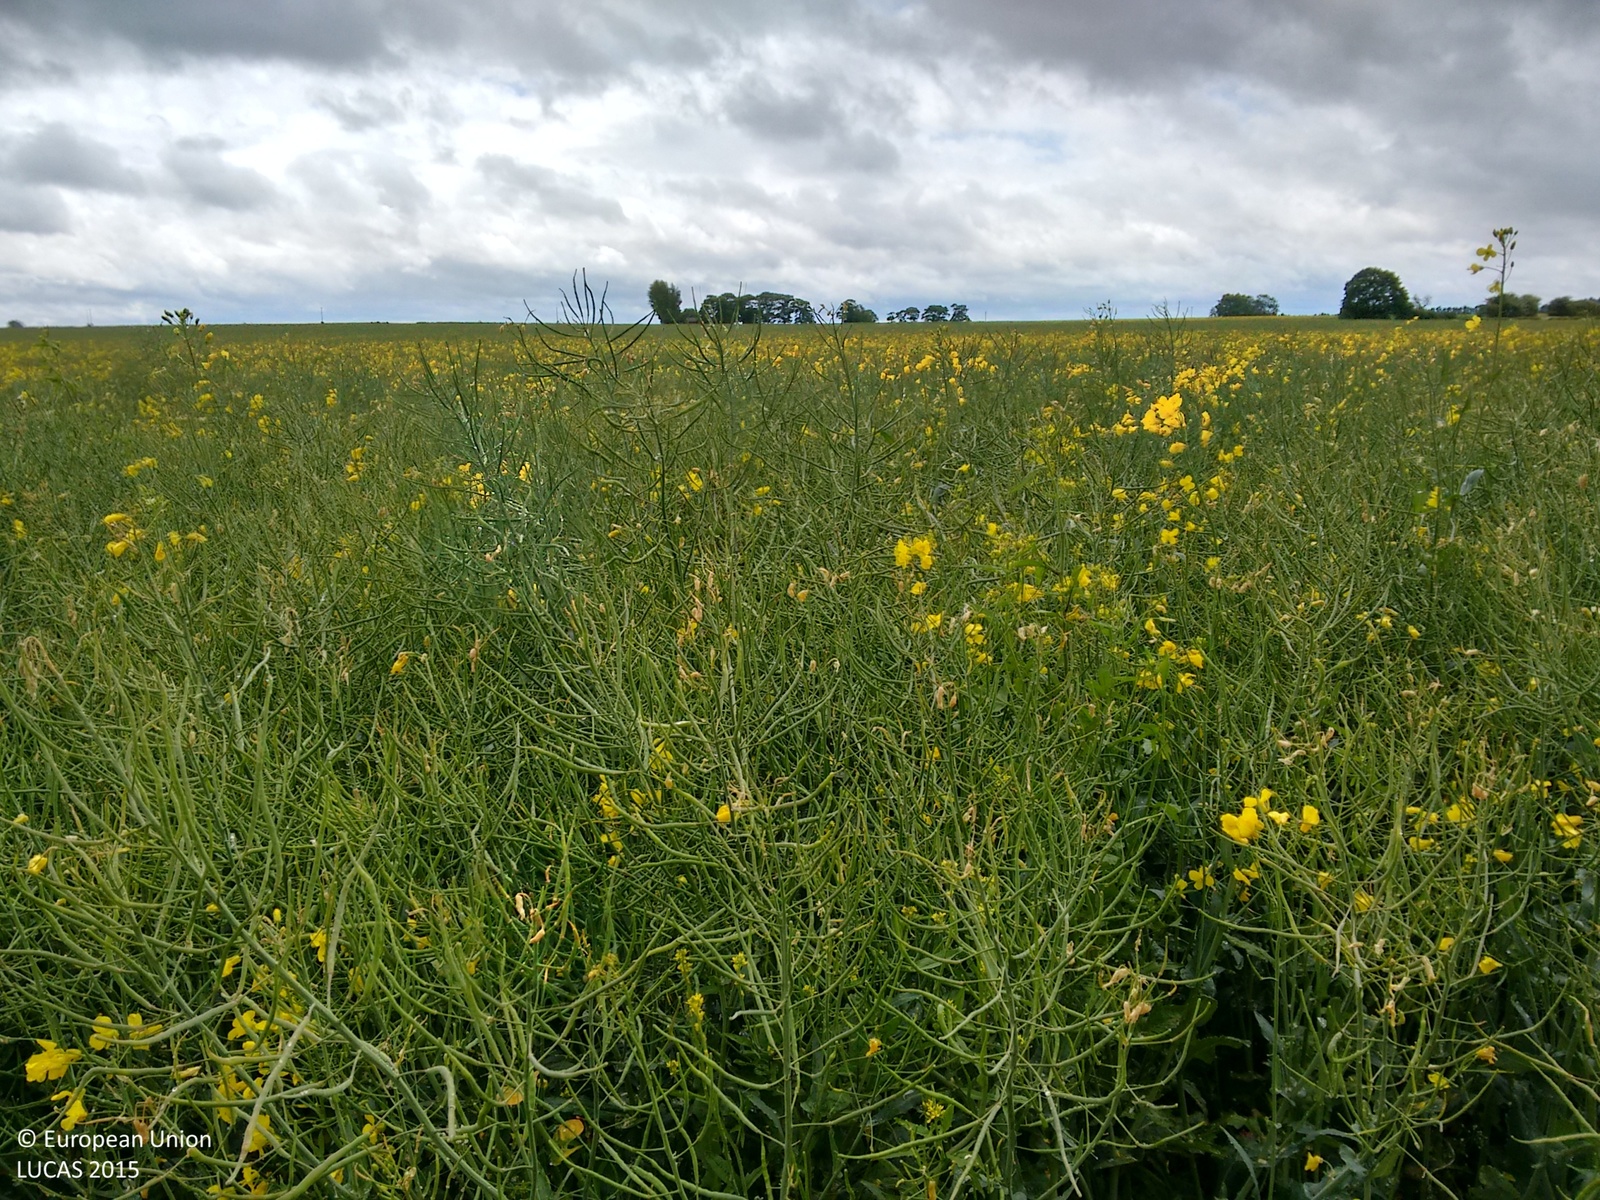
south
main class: Cropland
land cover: Rape and turnip rape
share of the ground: > 75 %
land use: Agriculture (excluding fallow land and kitchen gardens)
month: June
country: GB
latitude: 53.2768
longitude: -0.2171
